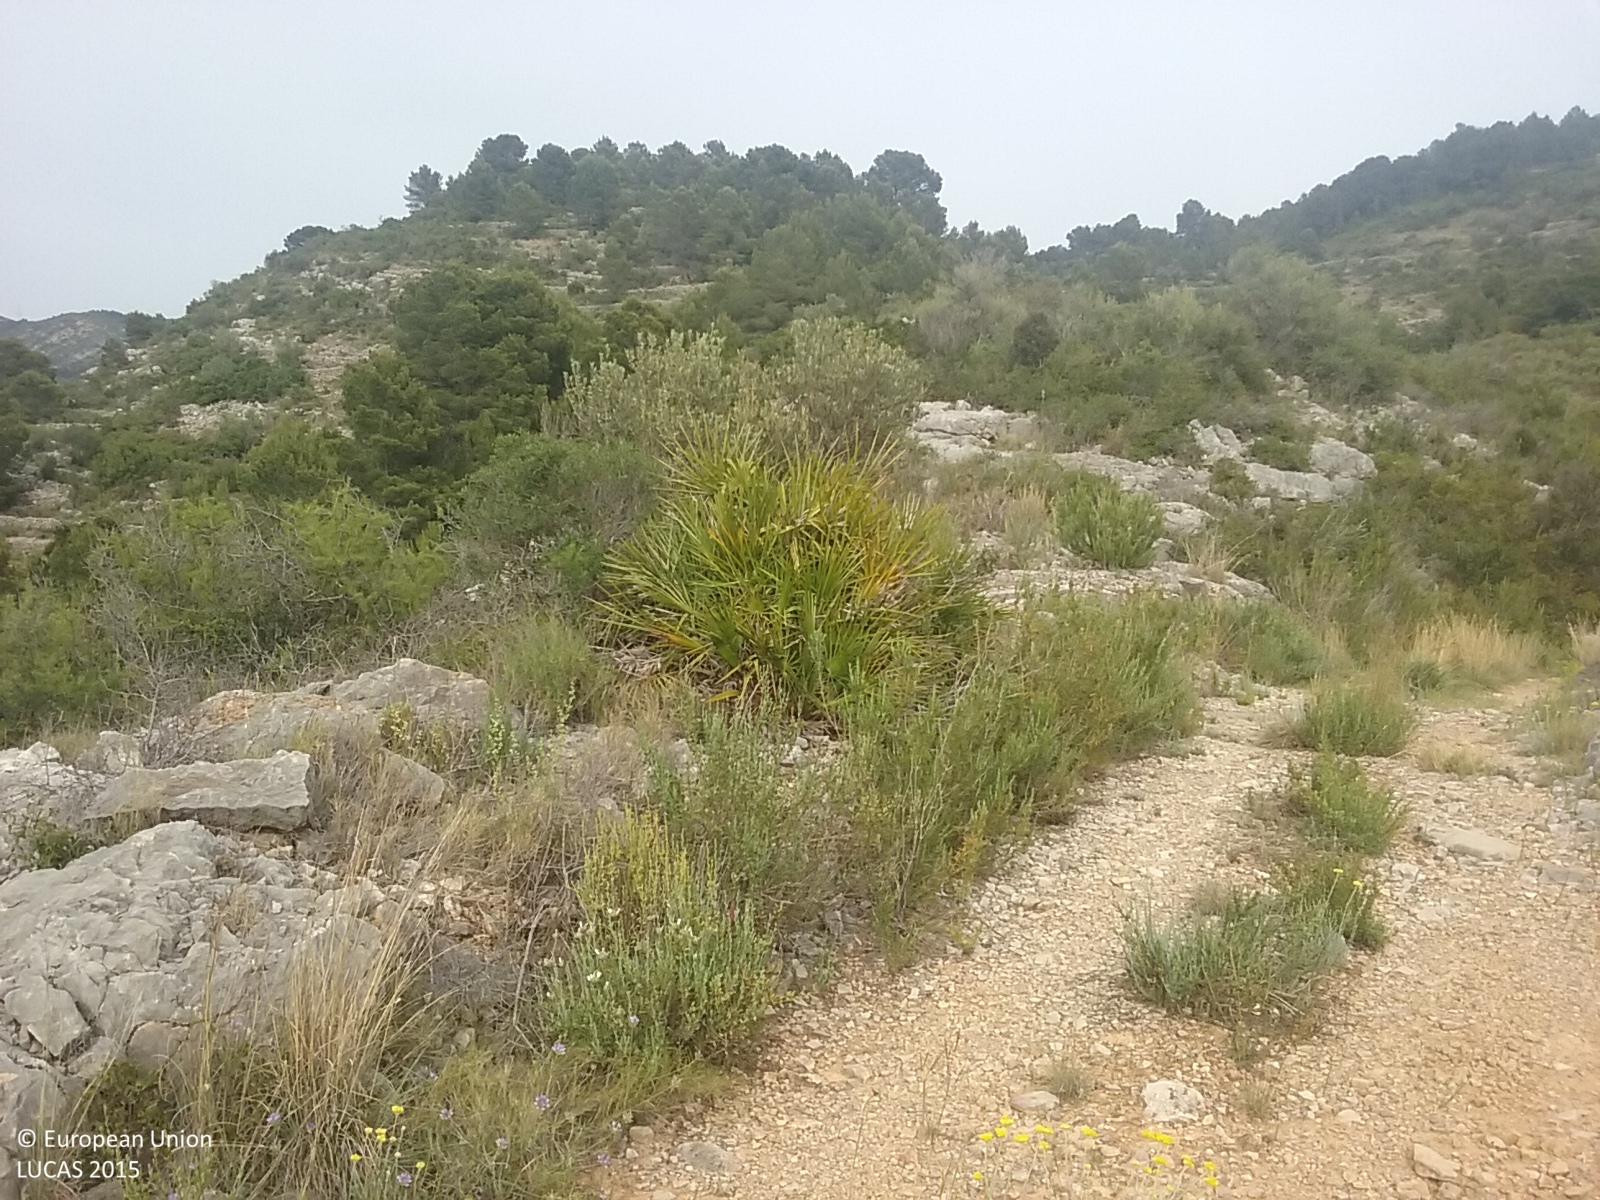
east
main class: Shrubland
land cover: Shrubland with sparse tree cover
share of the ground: > 75 %
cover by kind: shrubs 90 %, broadleaved forest trees 5 %
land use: Semi-natural and natural areas not in use
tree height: < 5 m
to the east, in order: Shrubland with sparse tree cover; Tracks; Shrubland with sparse tree cover; Dry stone walls; Shrubland with sparse tree cover; Dry stone walls; Shrubland with sparse tree cover; Dry stone walls; Shrubland with sparse tree cover; Dry stone walls; Shrubland with sparse tree cover; Dry stone walls; Shrubland with sparse tree cover; Dry stone walls; Shrubland with sparse tree cover; Dry stone walls; Shrubland with sparse tree cover; Dry stone walls; Shrubland with sparse tree cover; Dry stone walls; Shrubland with sparse tree cover; Dry stone walls; Shrubland with sparse tree cover; Dry stone walls; Pine dominated coniferous woodland; Dry stone walls; Pine dominated coniferous woodland; Dry stone walls; Shrubland with sparse tree cover; Dry stone walls; Shrubland with sparse tree cover
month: May
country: ES
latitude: 40.8490
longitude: 0.5638
